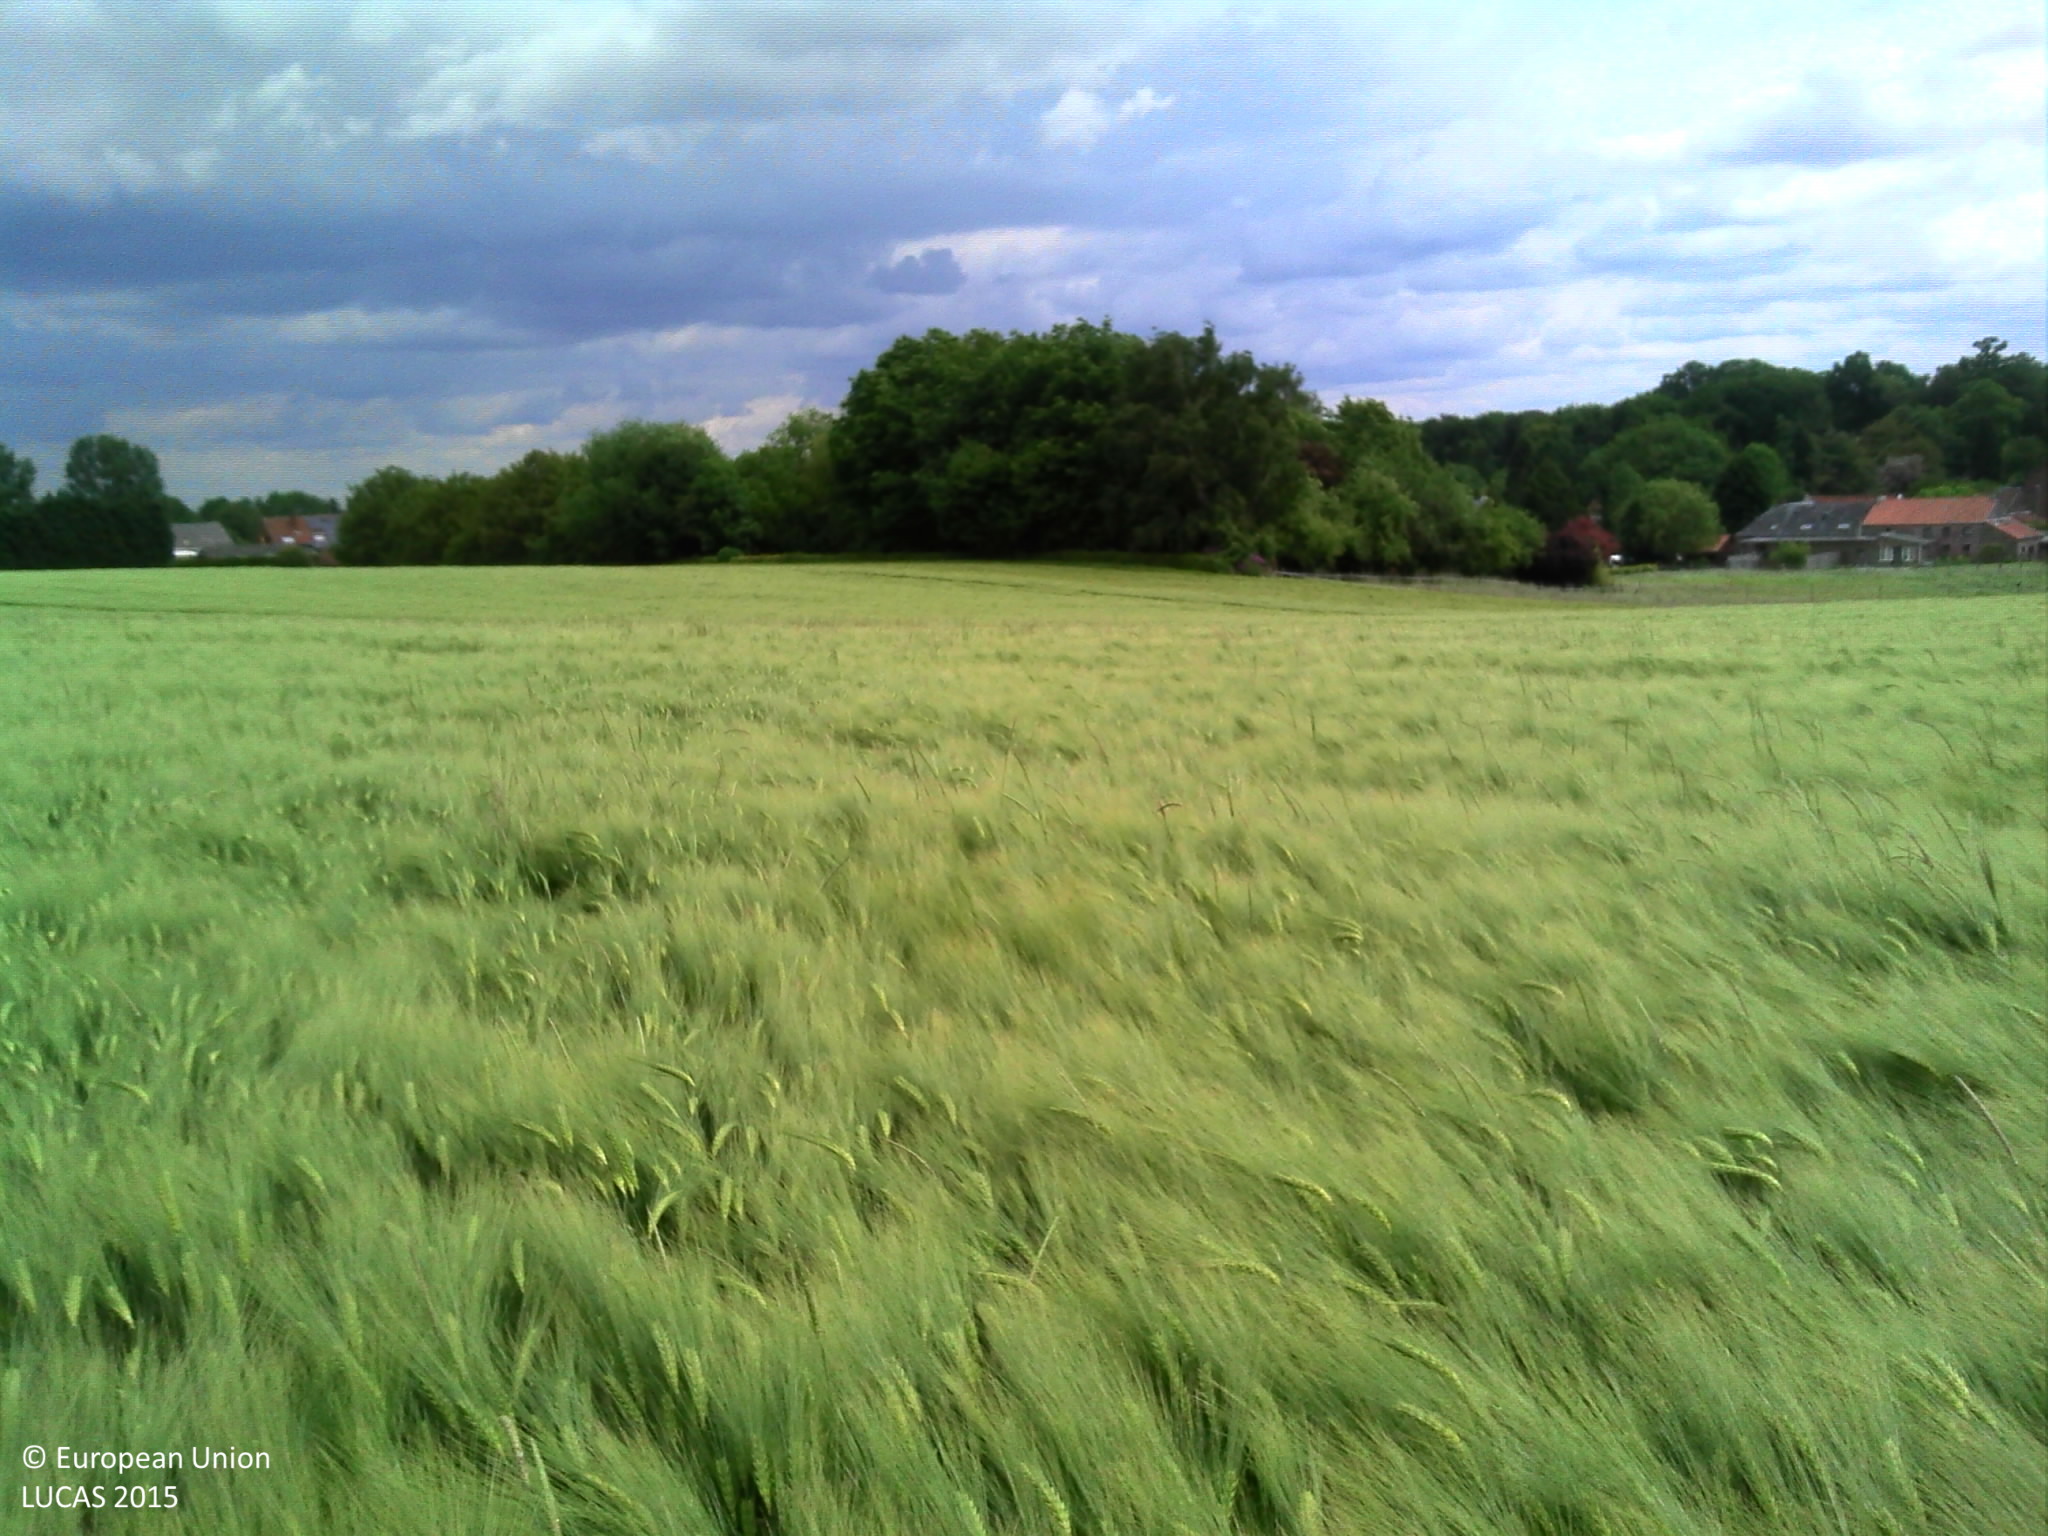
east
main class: Cropland
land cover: Barley
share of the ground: > 75 %
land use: Agriculture (excluding fallow land and kitchen gardens)
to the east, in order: Barley; Fences; Cherry fruit; Grassland with sparse tree/shrub cover; Artificial constructions in urban areas
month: May
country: BE
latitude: 50.6592
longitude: 4.7767
